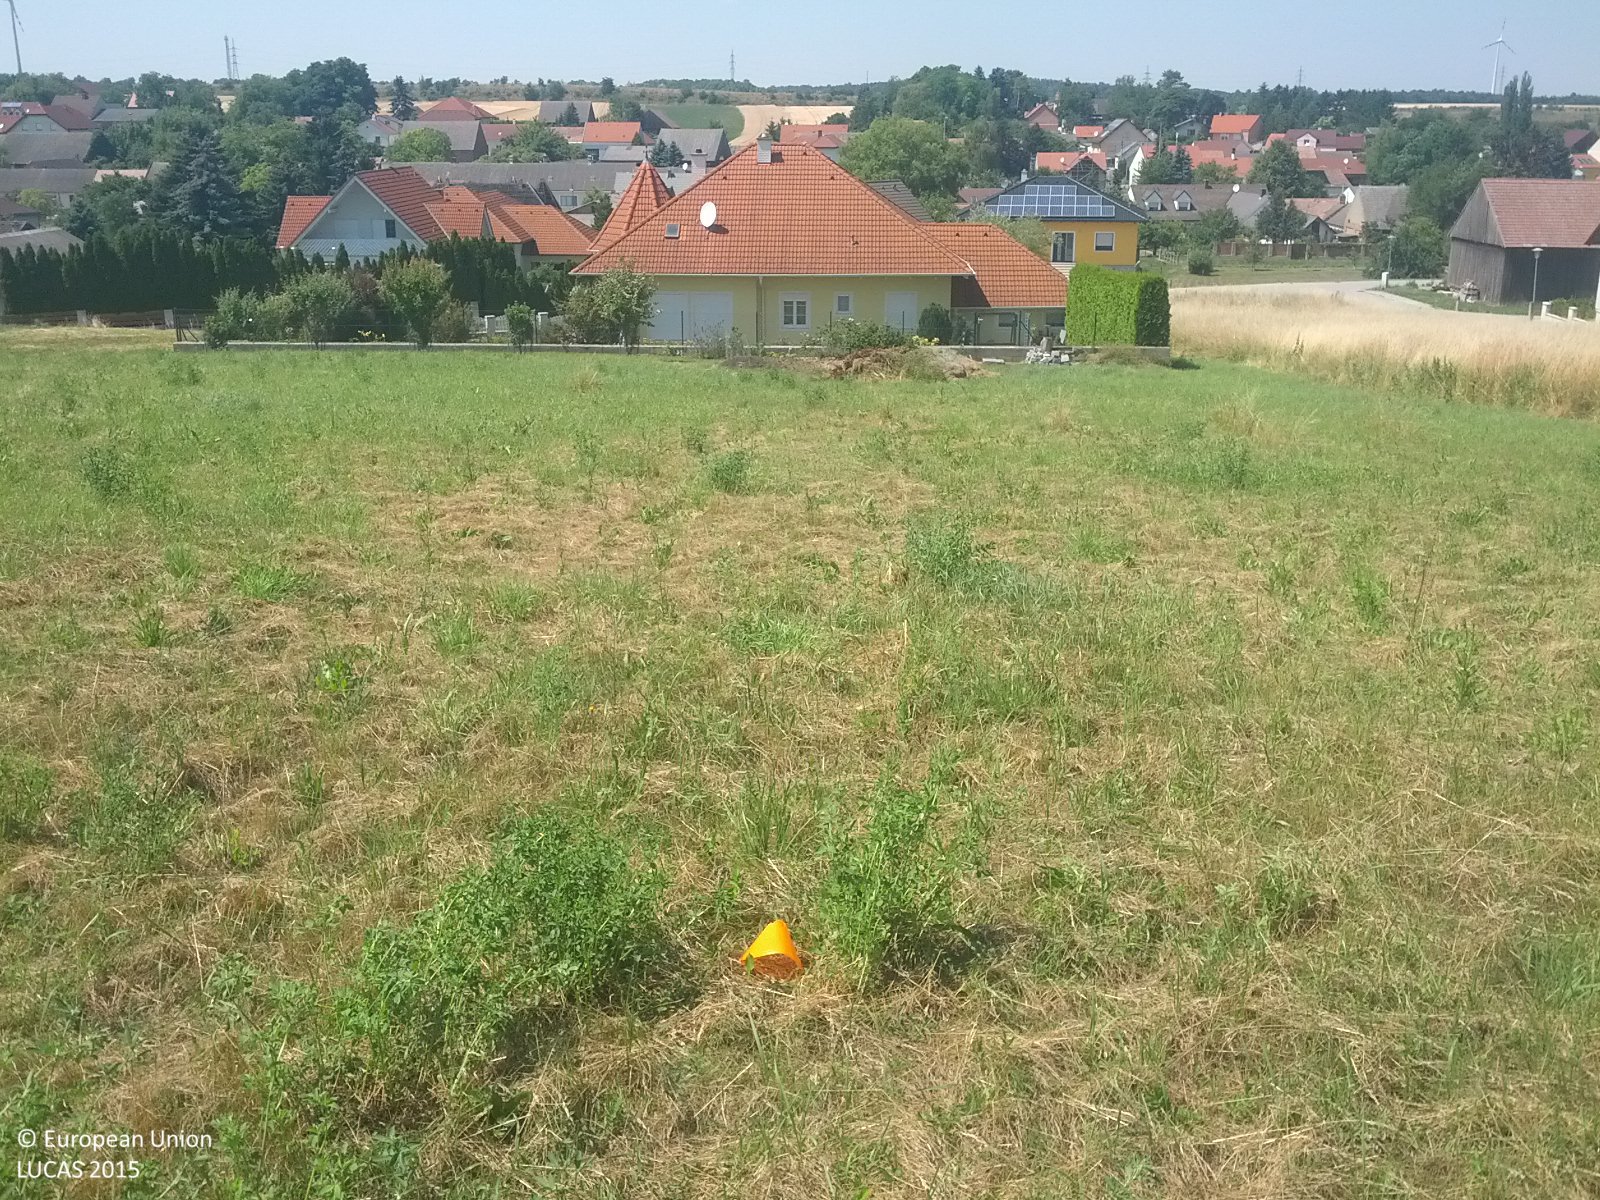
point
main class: Grassland
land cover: Grassland without tree/shrub cover
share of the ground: > 75 %
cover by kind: herbaceous plants 100 %
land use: Agriculture (excluding fallow land and kitchen gardens)
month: July
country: AT
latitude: 48.5116
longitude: 16.6260
